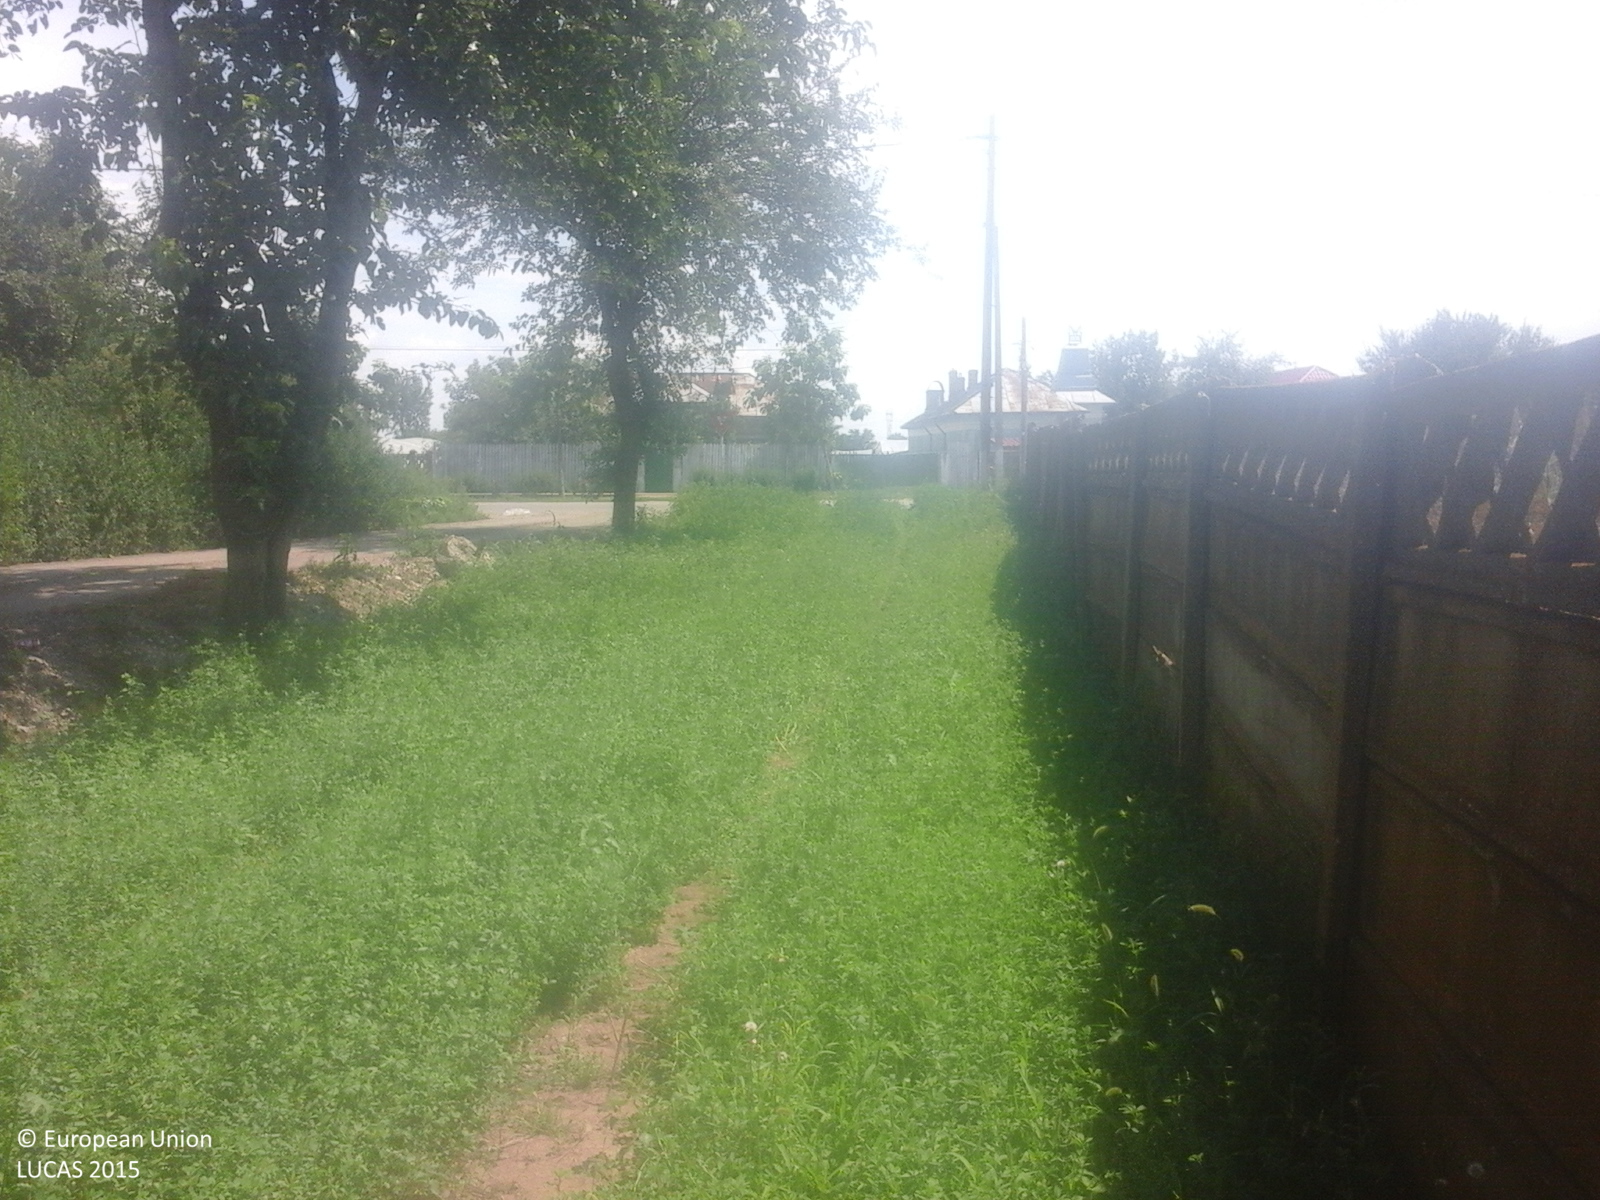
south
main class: Artificial land
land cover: Greenhouses
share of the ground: > 75 %
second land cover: Tomatoes
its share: > 75 %
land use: Agriculture (excluding fallow land and kitchen gardens)
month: July
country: RO
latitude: 43.8167
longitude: 24.6511
